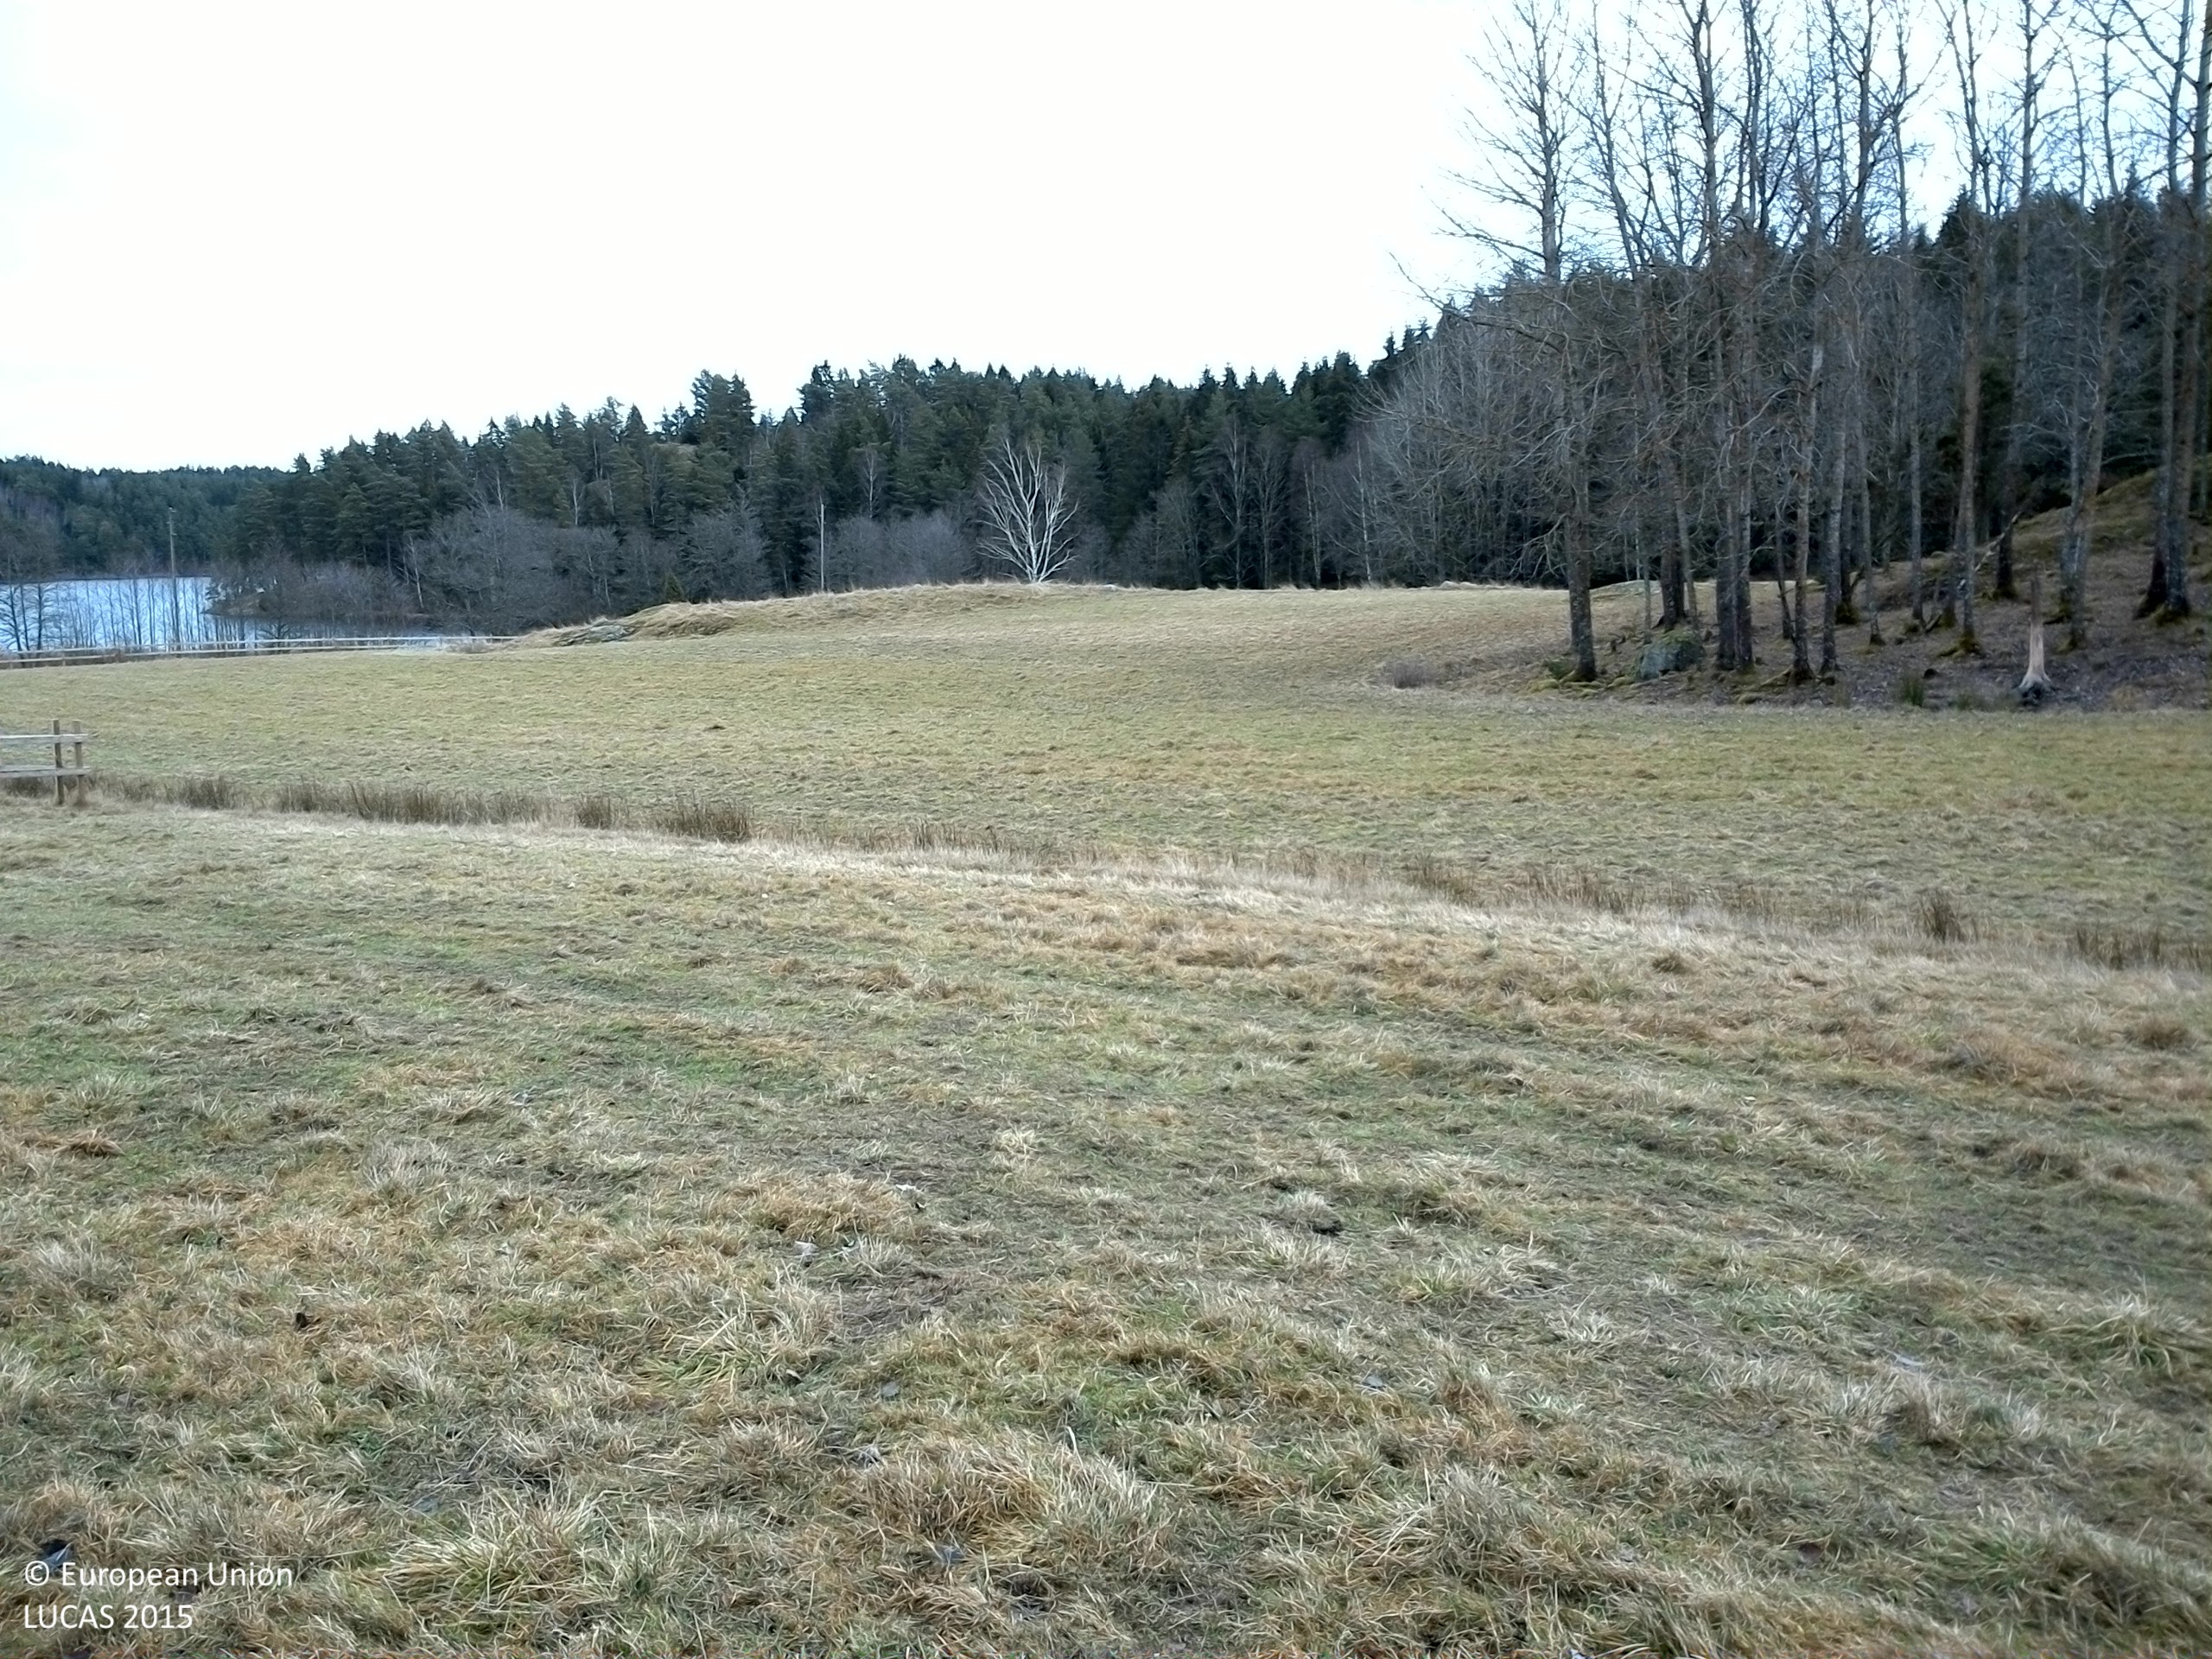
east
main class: Grassland
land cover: Grassland without tree/shrub cover
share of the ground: > 75 %
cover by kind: herbaceous plants 100 %
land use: Agriculture (excluding fallow land and kitchen gardens)
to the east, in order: Grassland without tree/shrub cover; Ditches and canals; Grassland without tree/shrub cover; Rock outcrops; Single bushes/trees; Grassland without tree/shrub cover; Fences; Grassland without tree/shrub cover; Rock outcrops; Electric lines; Grassland without tree/shrub cover; Abandoned hedges; Inland marshes; Inland fresh water bodies
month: November
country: SE
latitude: 58.9762
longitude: 17.0062
